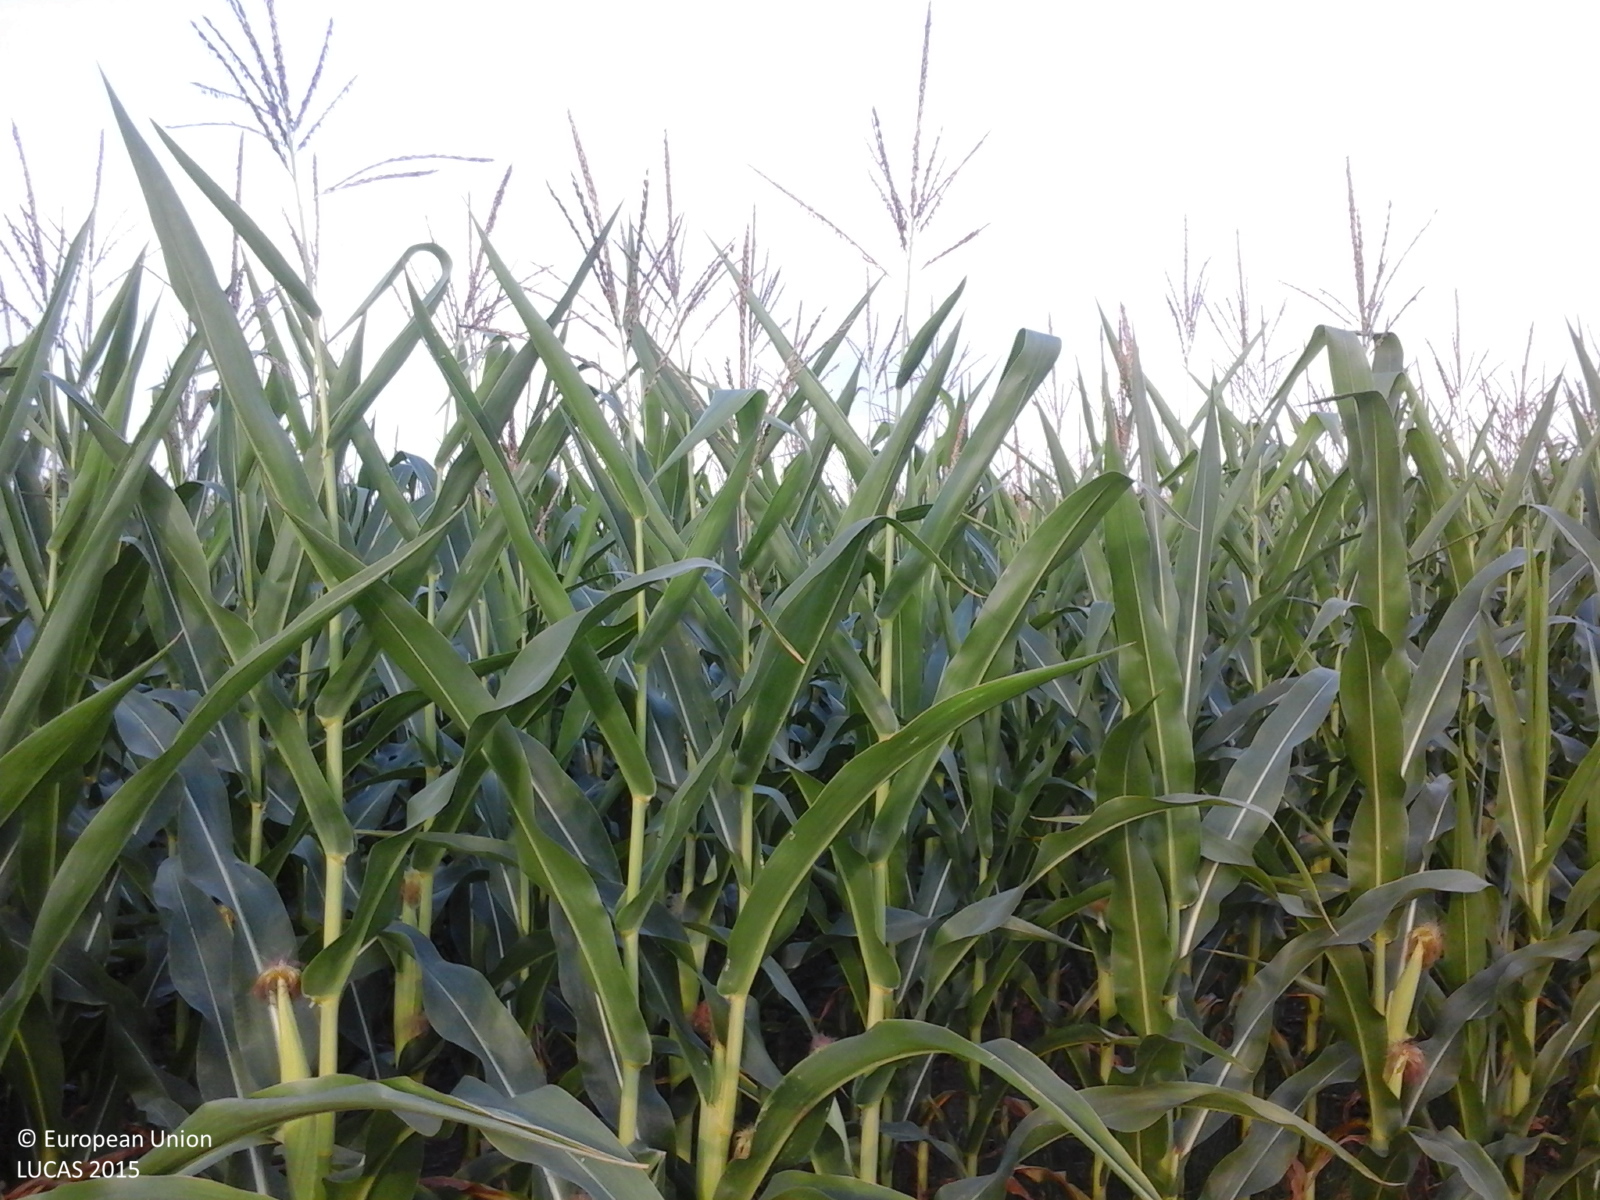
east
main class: Cropland
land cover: Maize
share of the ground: > 75 %
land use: Agriculture (excluding fallow land and kitchen gardens)
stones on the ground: < 10 %
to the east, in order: Maize; Grassland without tree/shrub cover; Maize; Grassland without tree/shrub cover; Ditches and canals; Grass margins; Paved roads, cycling and walking lanes; Grassland without tree/shrub cover; Tracks; Grassland without tree/shrub cover; Tracks; Grassland without tree/shrub cover; Electric lines; Grassland without tree/shrub cover; Fences; Abandoned hedges; Vineyards
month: July
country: RO
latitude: 46.2315
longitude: 26.7489
